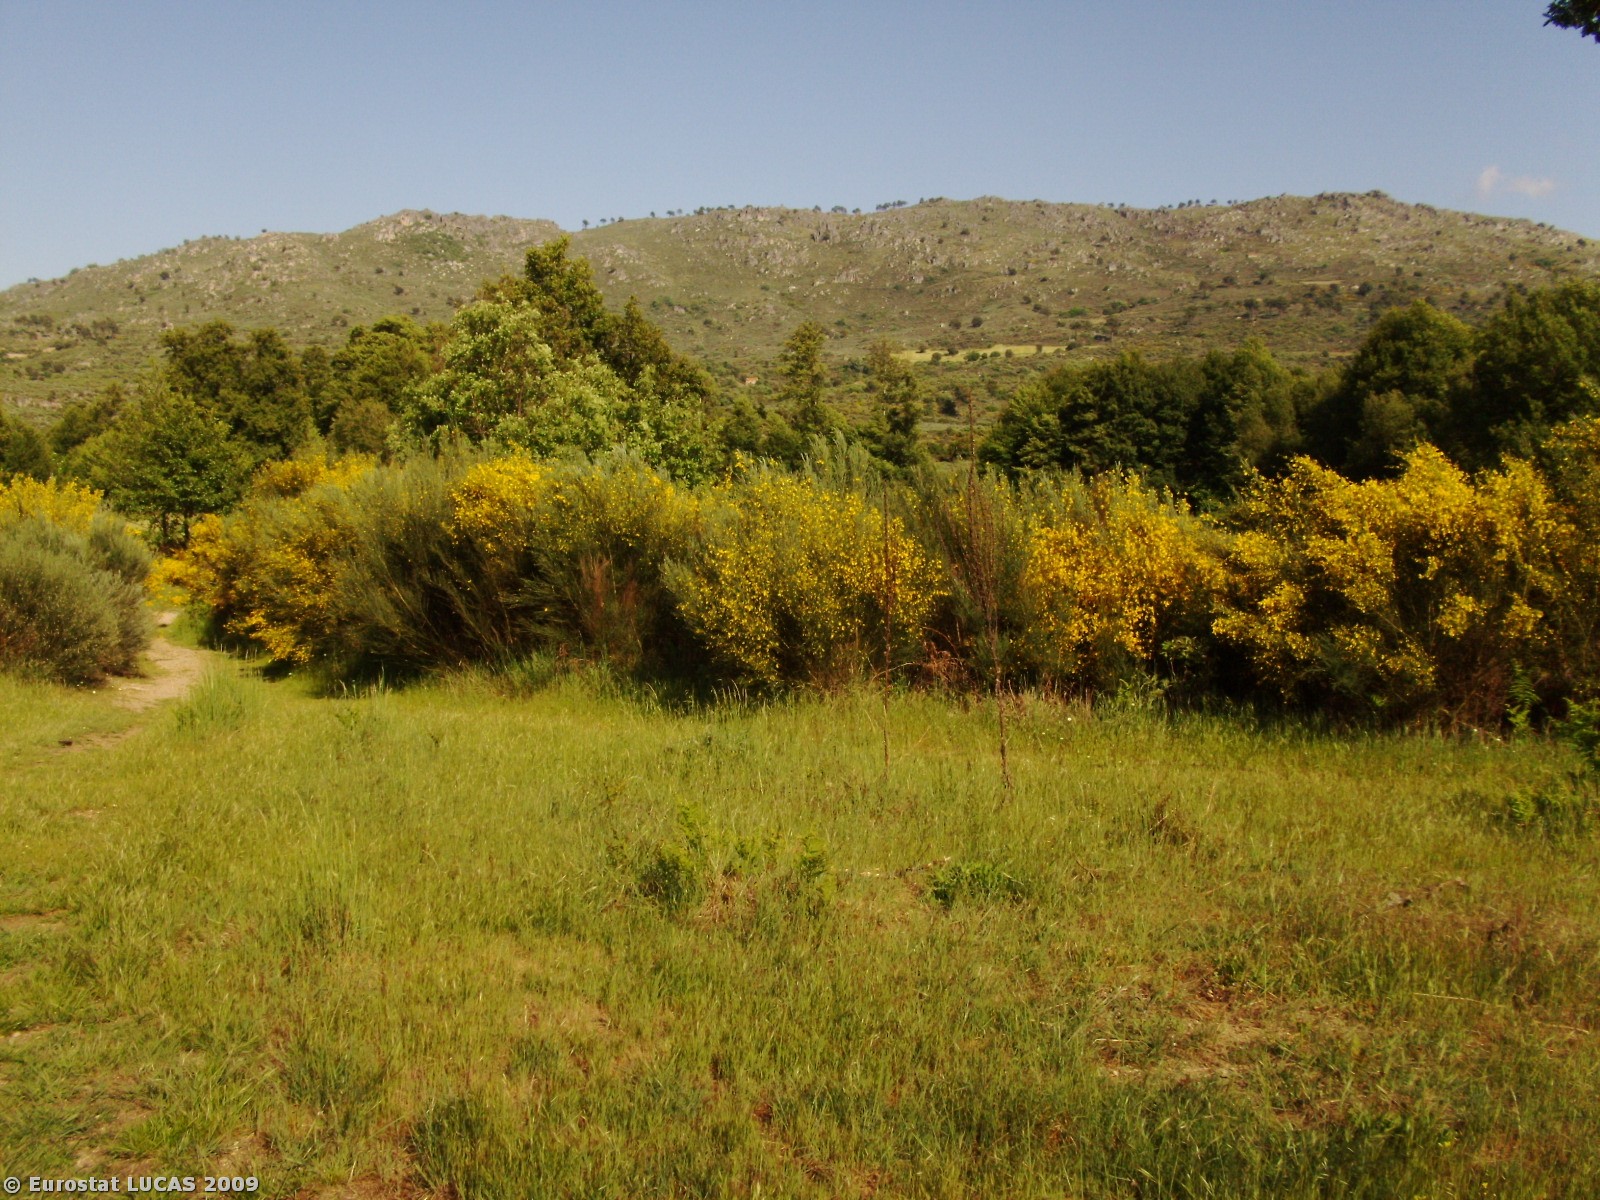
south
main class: Shrubland
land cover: Shrubland with sparse tree cover
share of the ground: > 75 %
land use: Nature reserves
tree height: > 5 m
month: May
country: PT
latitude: 40.6080
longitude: -7.3527
